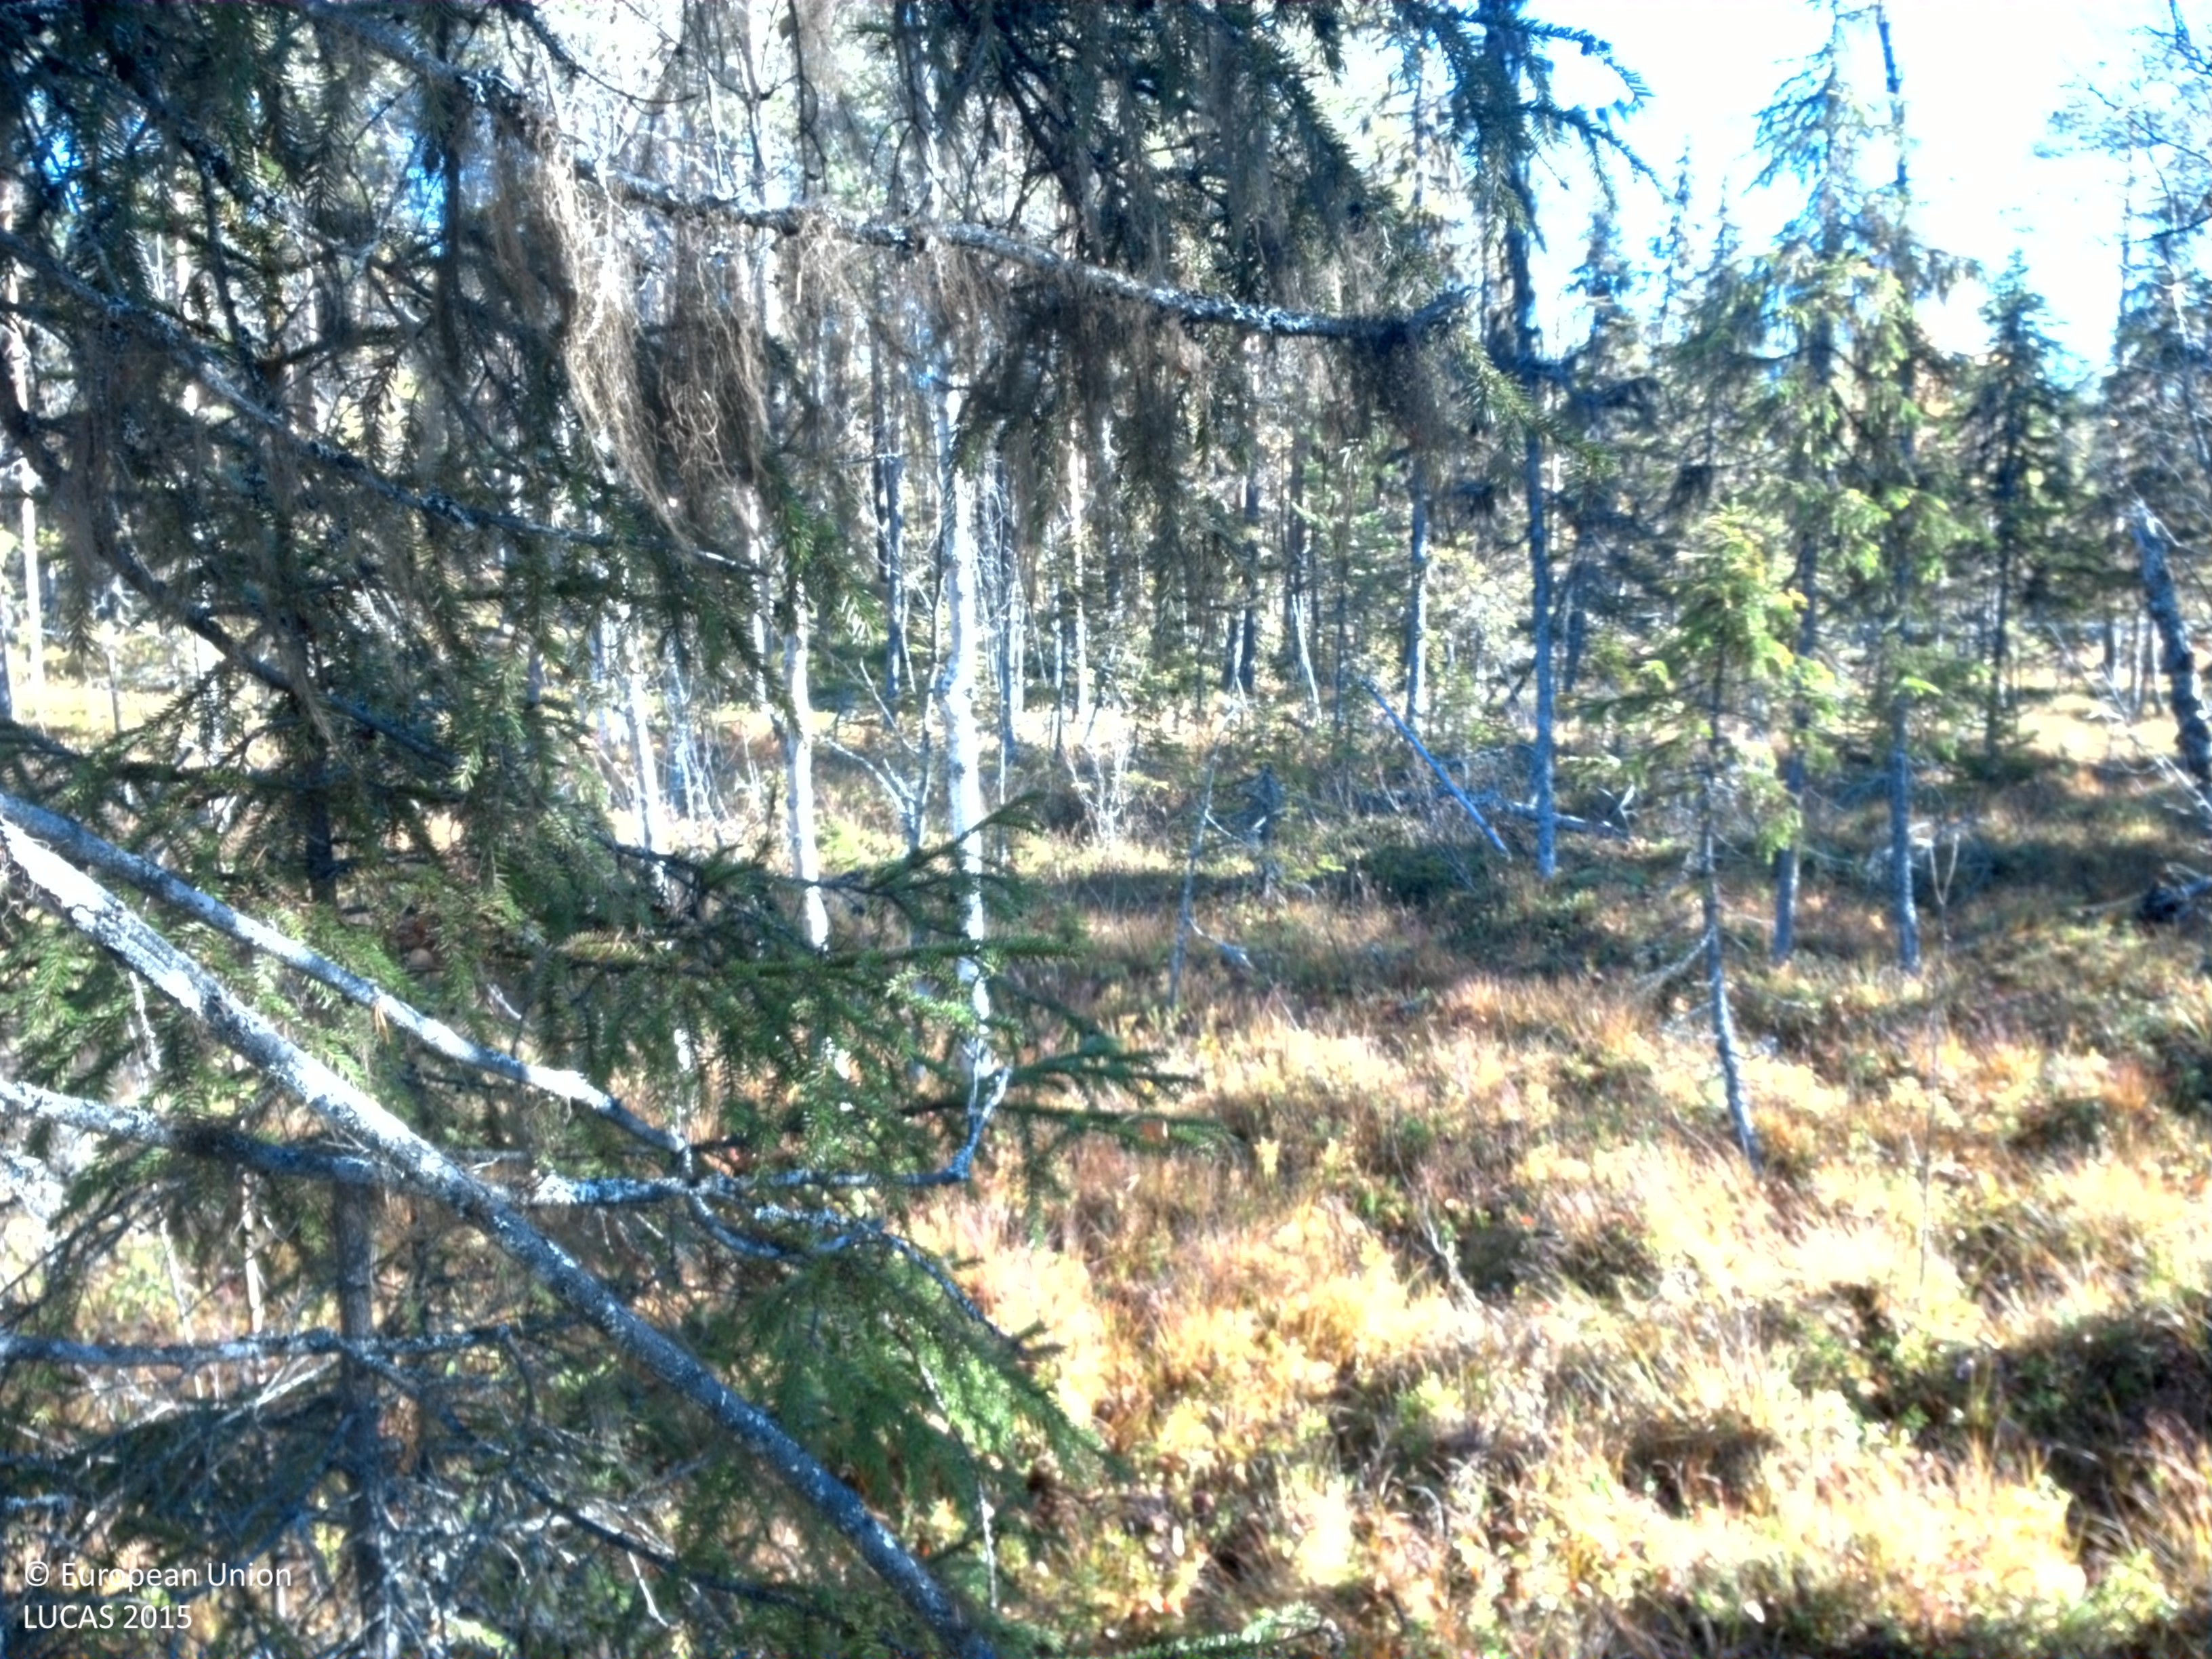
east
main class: Woodland
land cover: Spruce dominated mixed woodland
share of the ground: 25 - 50 %
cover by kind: shrubs 50 %, coniferous forest trees 20 %, broadleaved forest trees 15 %, lichens and mosses 10 %, herbaceous plants 5 %
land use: Forestry
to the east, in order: Spruce dominated mixed woodland; Other coniferous woodland; Shrubland with sparse tree cover; Paved roads, cycling and walking lanes; Shrubland with sparse tree cover; Other mixed woodland; Pine dominated mixed woodland
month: September
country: SE
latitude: 64.9681
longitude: 17.8221
